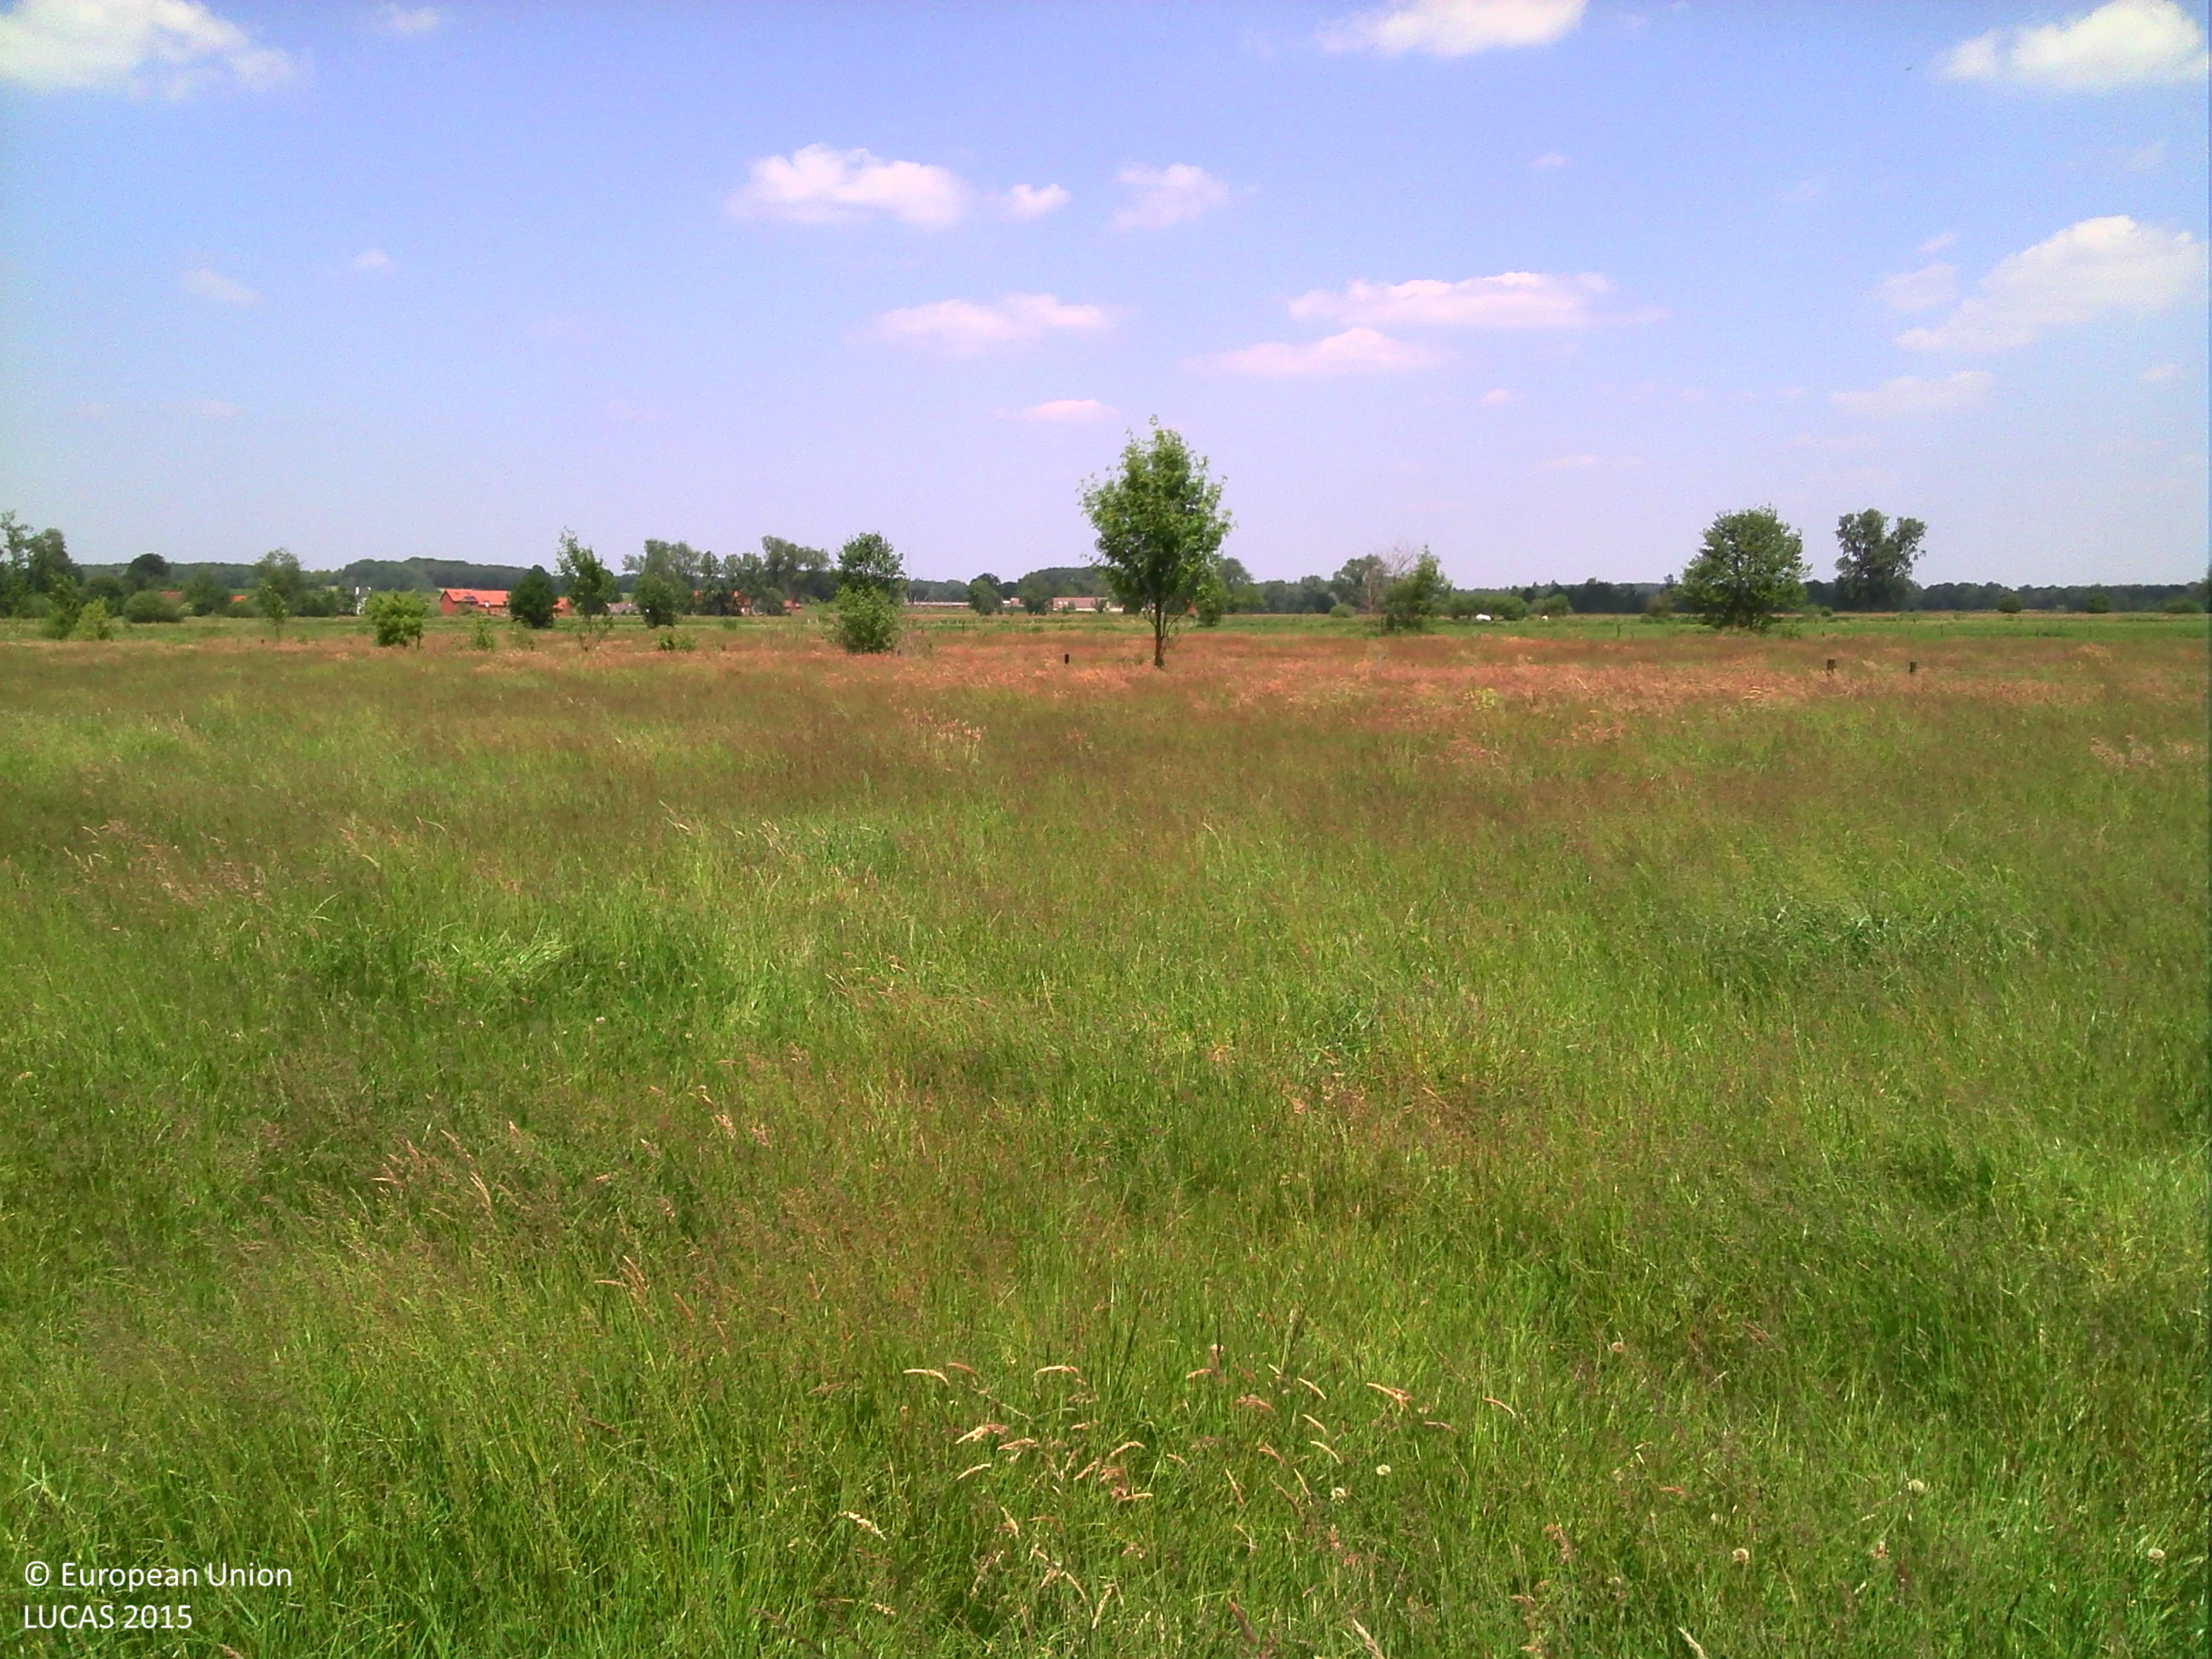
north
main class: Grassland
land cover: Grassland without tree/shrub cover
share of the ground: > 75 %
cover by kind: herbaceous plants 100 %
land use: Agriculture (excluding fallow land and kitchen gardens)
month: June
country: BE
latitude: 51.0005
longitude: 5.1668
